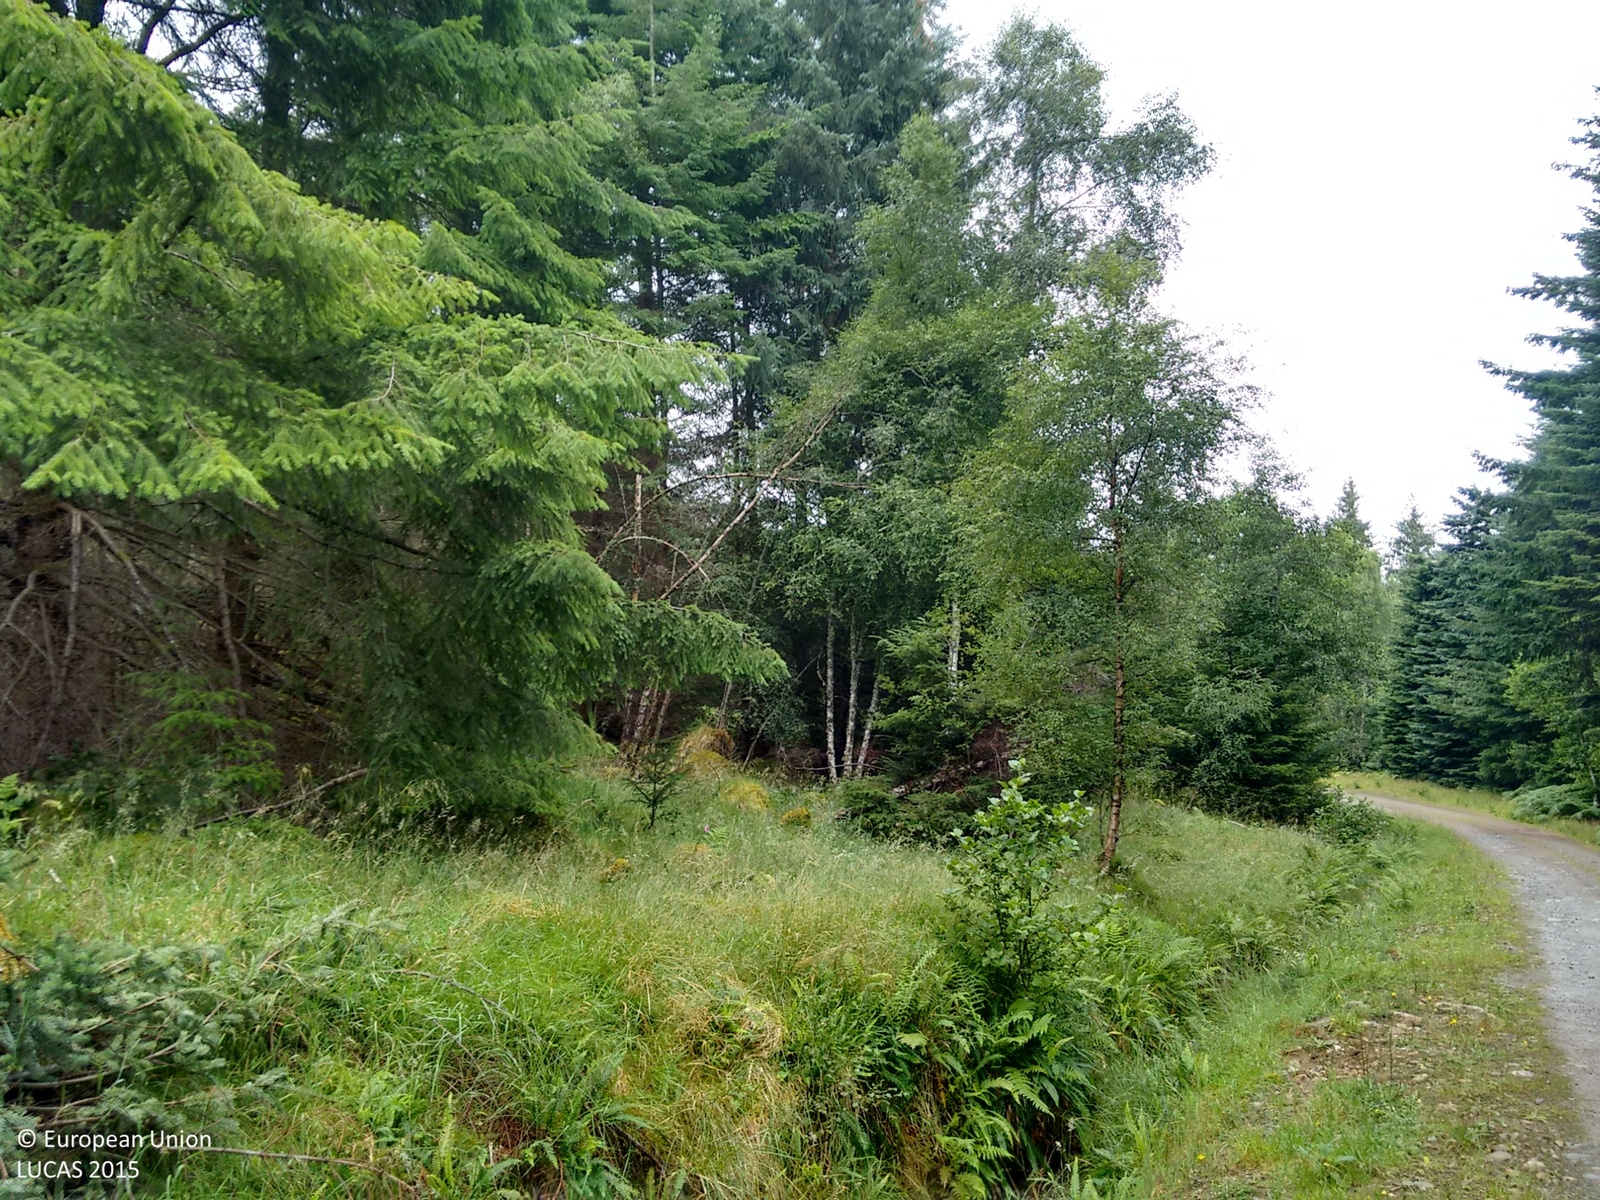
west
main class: Woodland
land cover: Spruce dominated coniferous woodland
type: exotic forest
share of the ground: > 75 %
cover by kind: coniferous forest trees 100 %
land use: Forestry
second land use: Amenities, museums, leisure
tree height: > 5 m
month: August
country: GB
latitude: 57.3288
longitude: -4.5602
